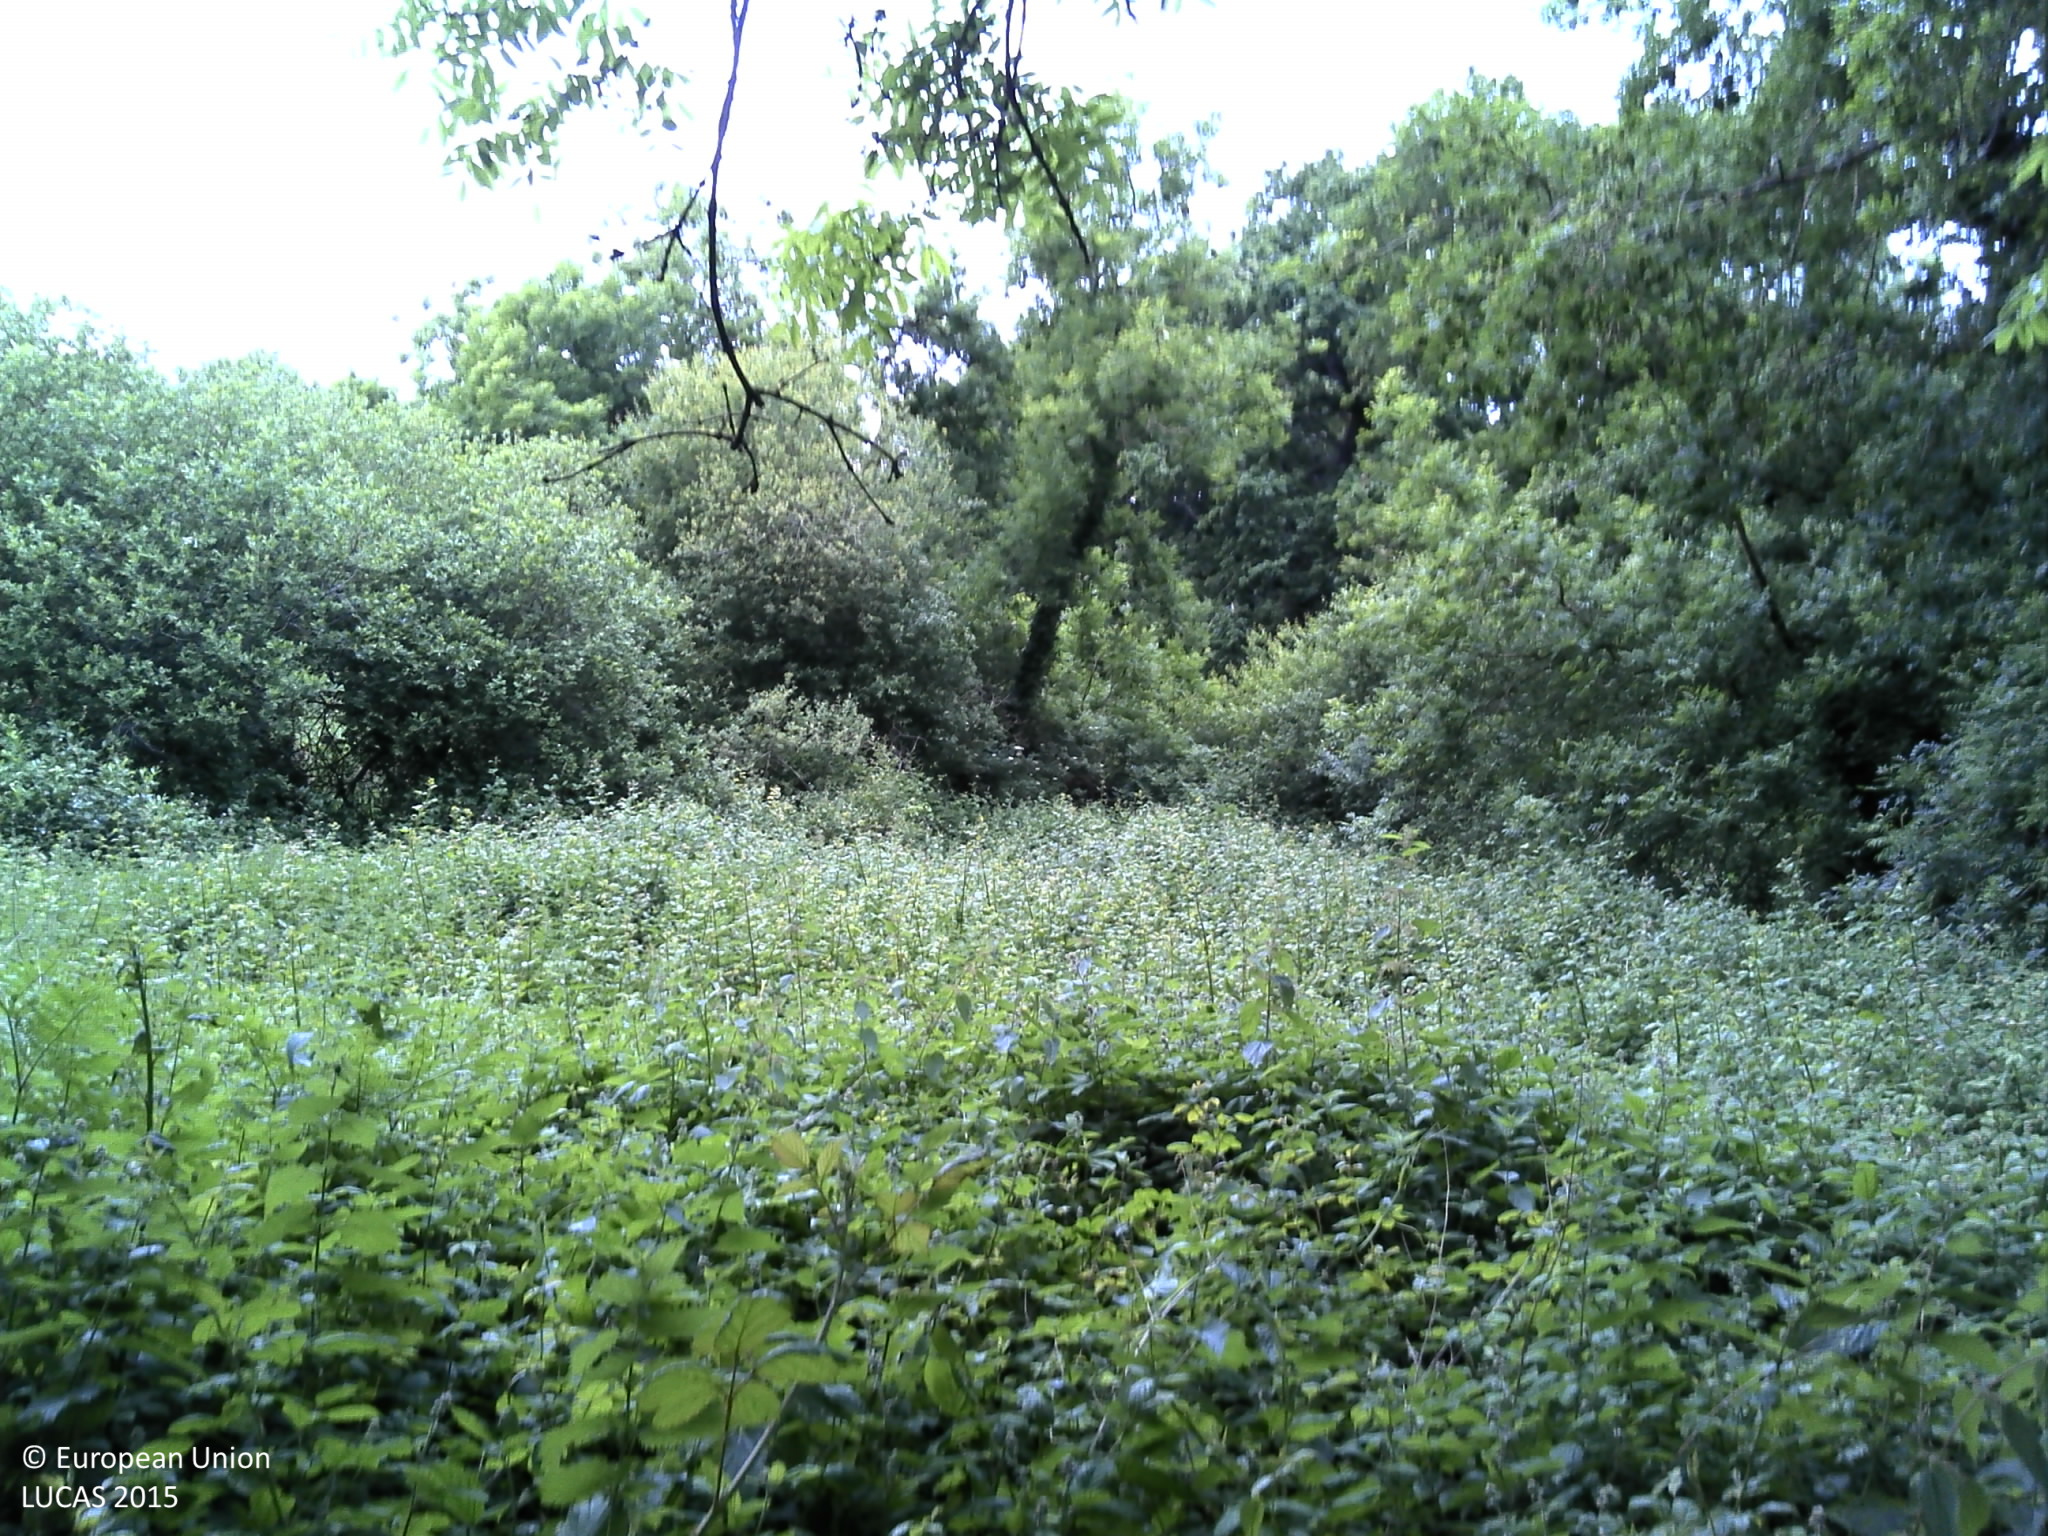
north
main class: Grassland
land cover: Spontaneously vegetated surfaces
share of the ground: > 75 %
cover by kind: herbaceous plants 95 %, shrubs 5 %
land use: Semi-natural and natural areas not in use
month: June
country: FR
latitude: 48.0421
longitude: -4.3796
